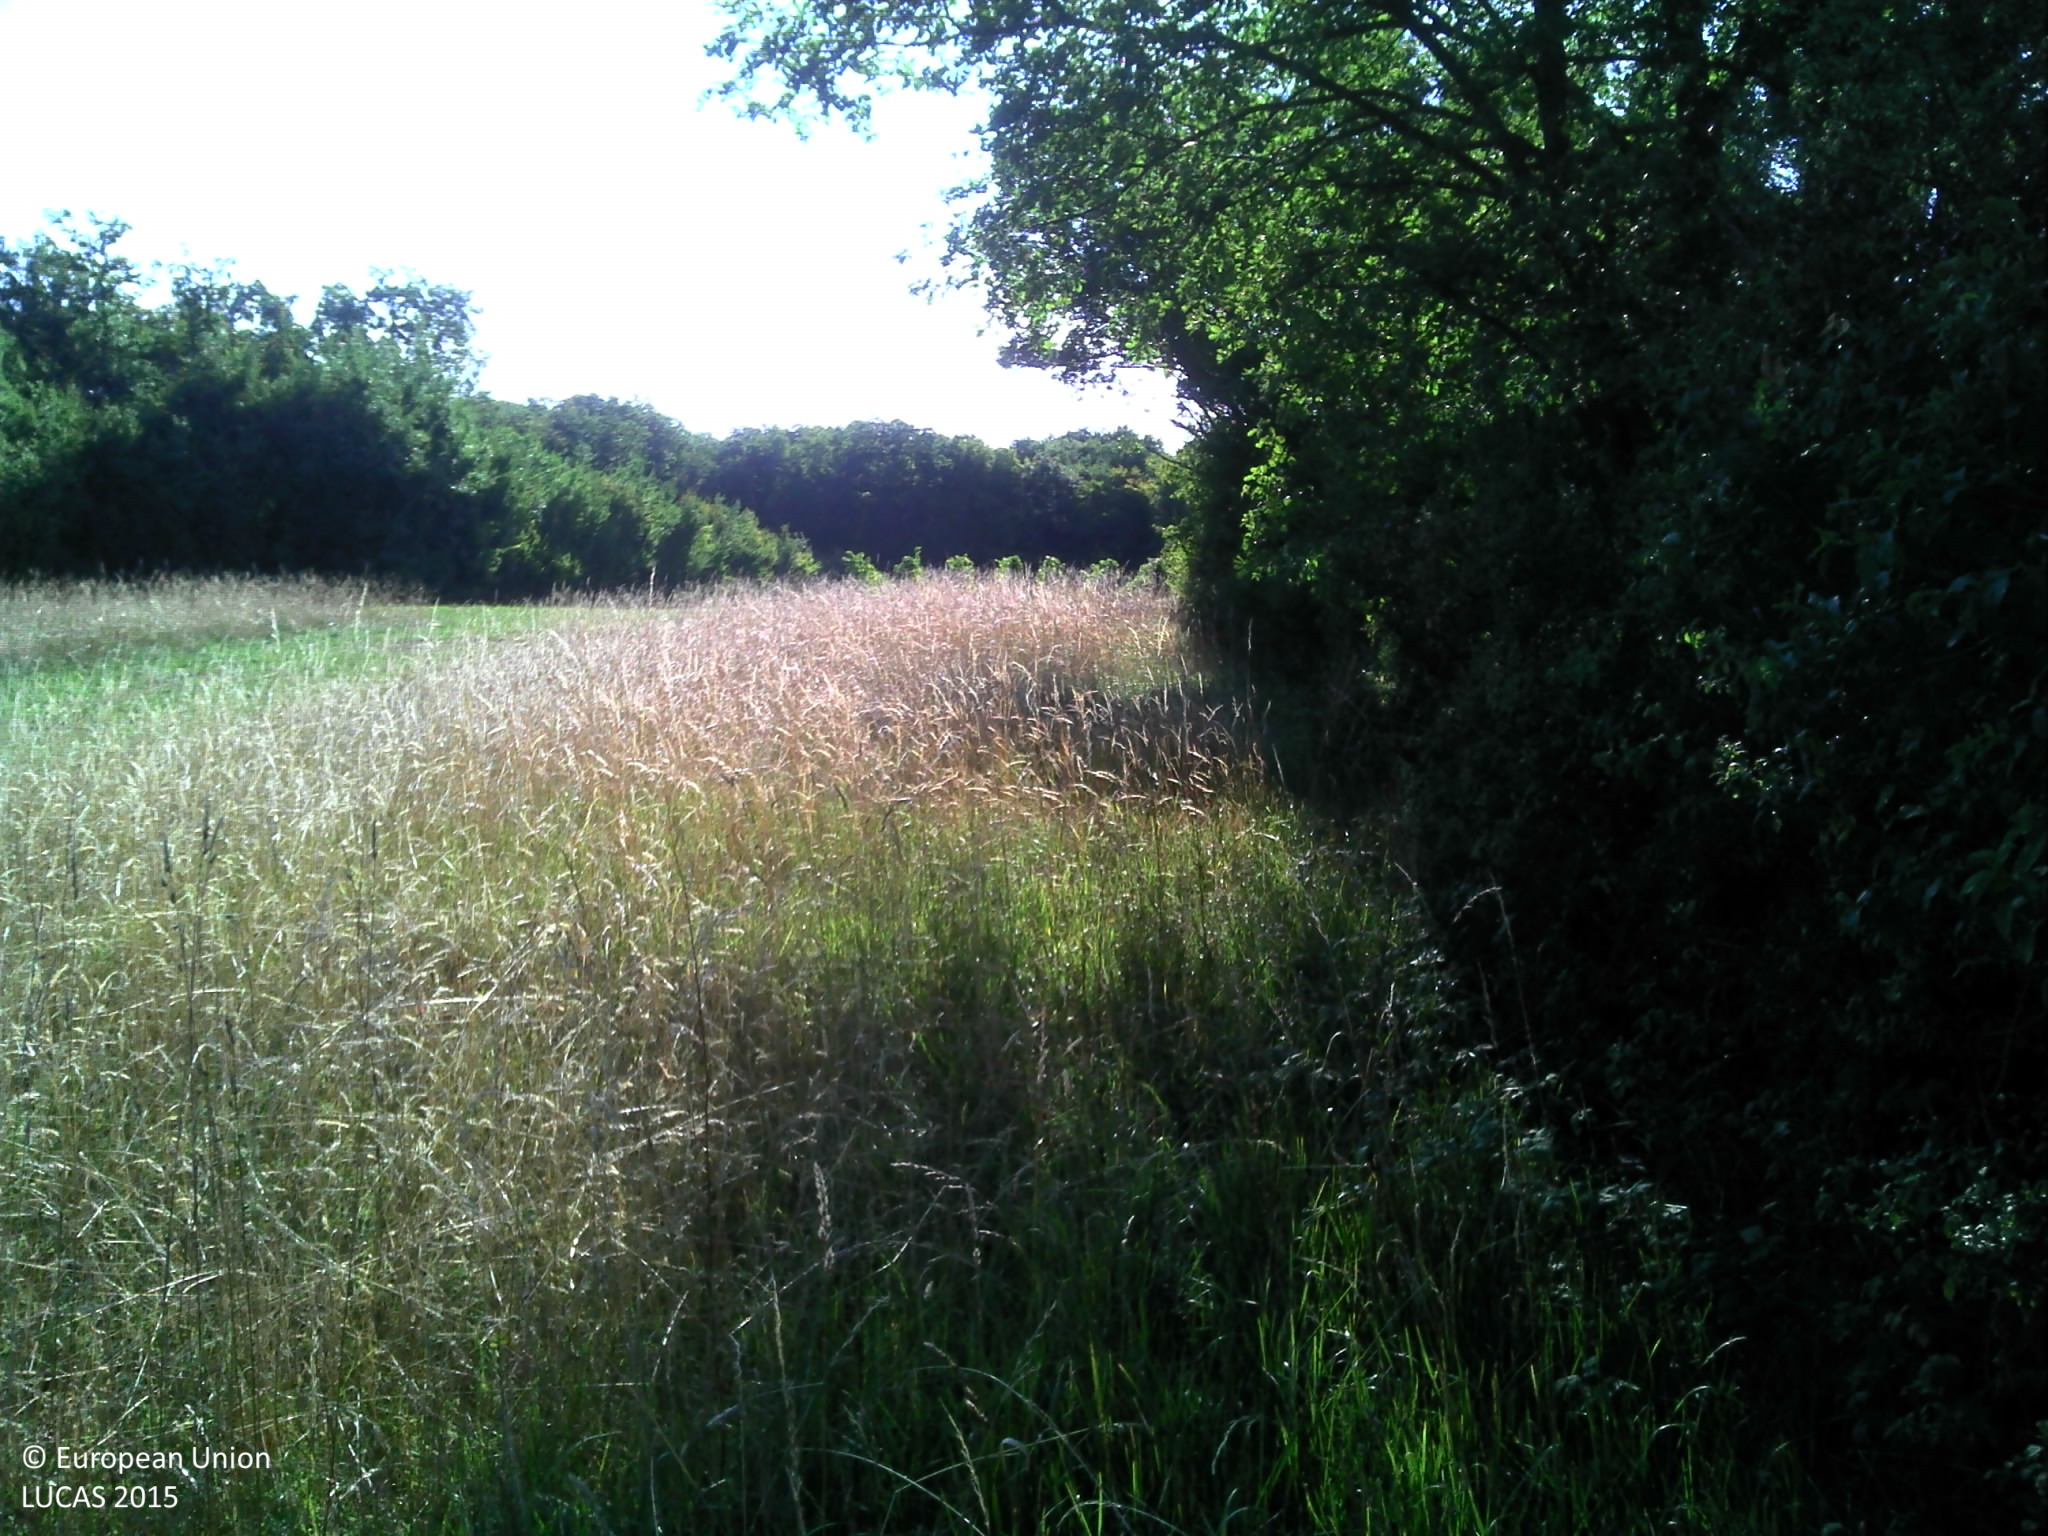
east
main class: Woodland
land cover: Broadleaved woodland
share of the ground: > 75 %
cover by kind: broadleaved forest trees 100 %
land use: Agriculture (excluding fallow land and kitchen gardens)
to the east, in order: Broadleaved woodland; Dry stone walls; Grassland without tree/shrub cover; Broadleaved woodland
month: August
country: FR
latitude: 46.4584
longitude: 4.7807
